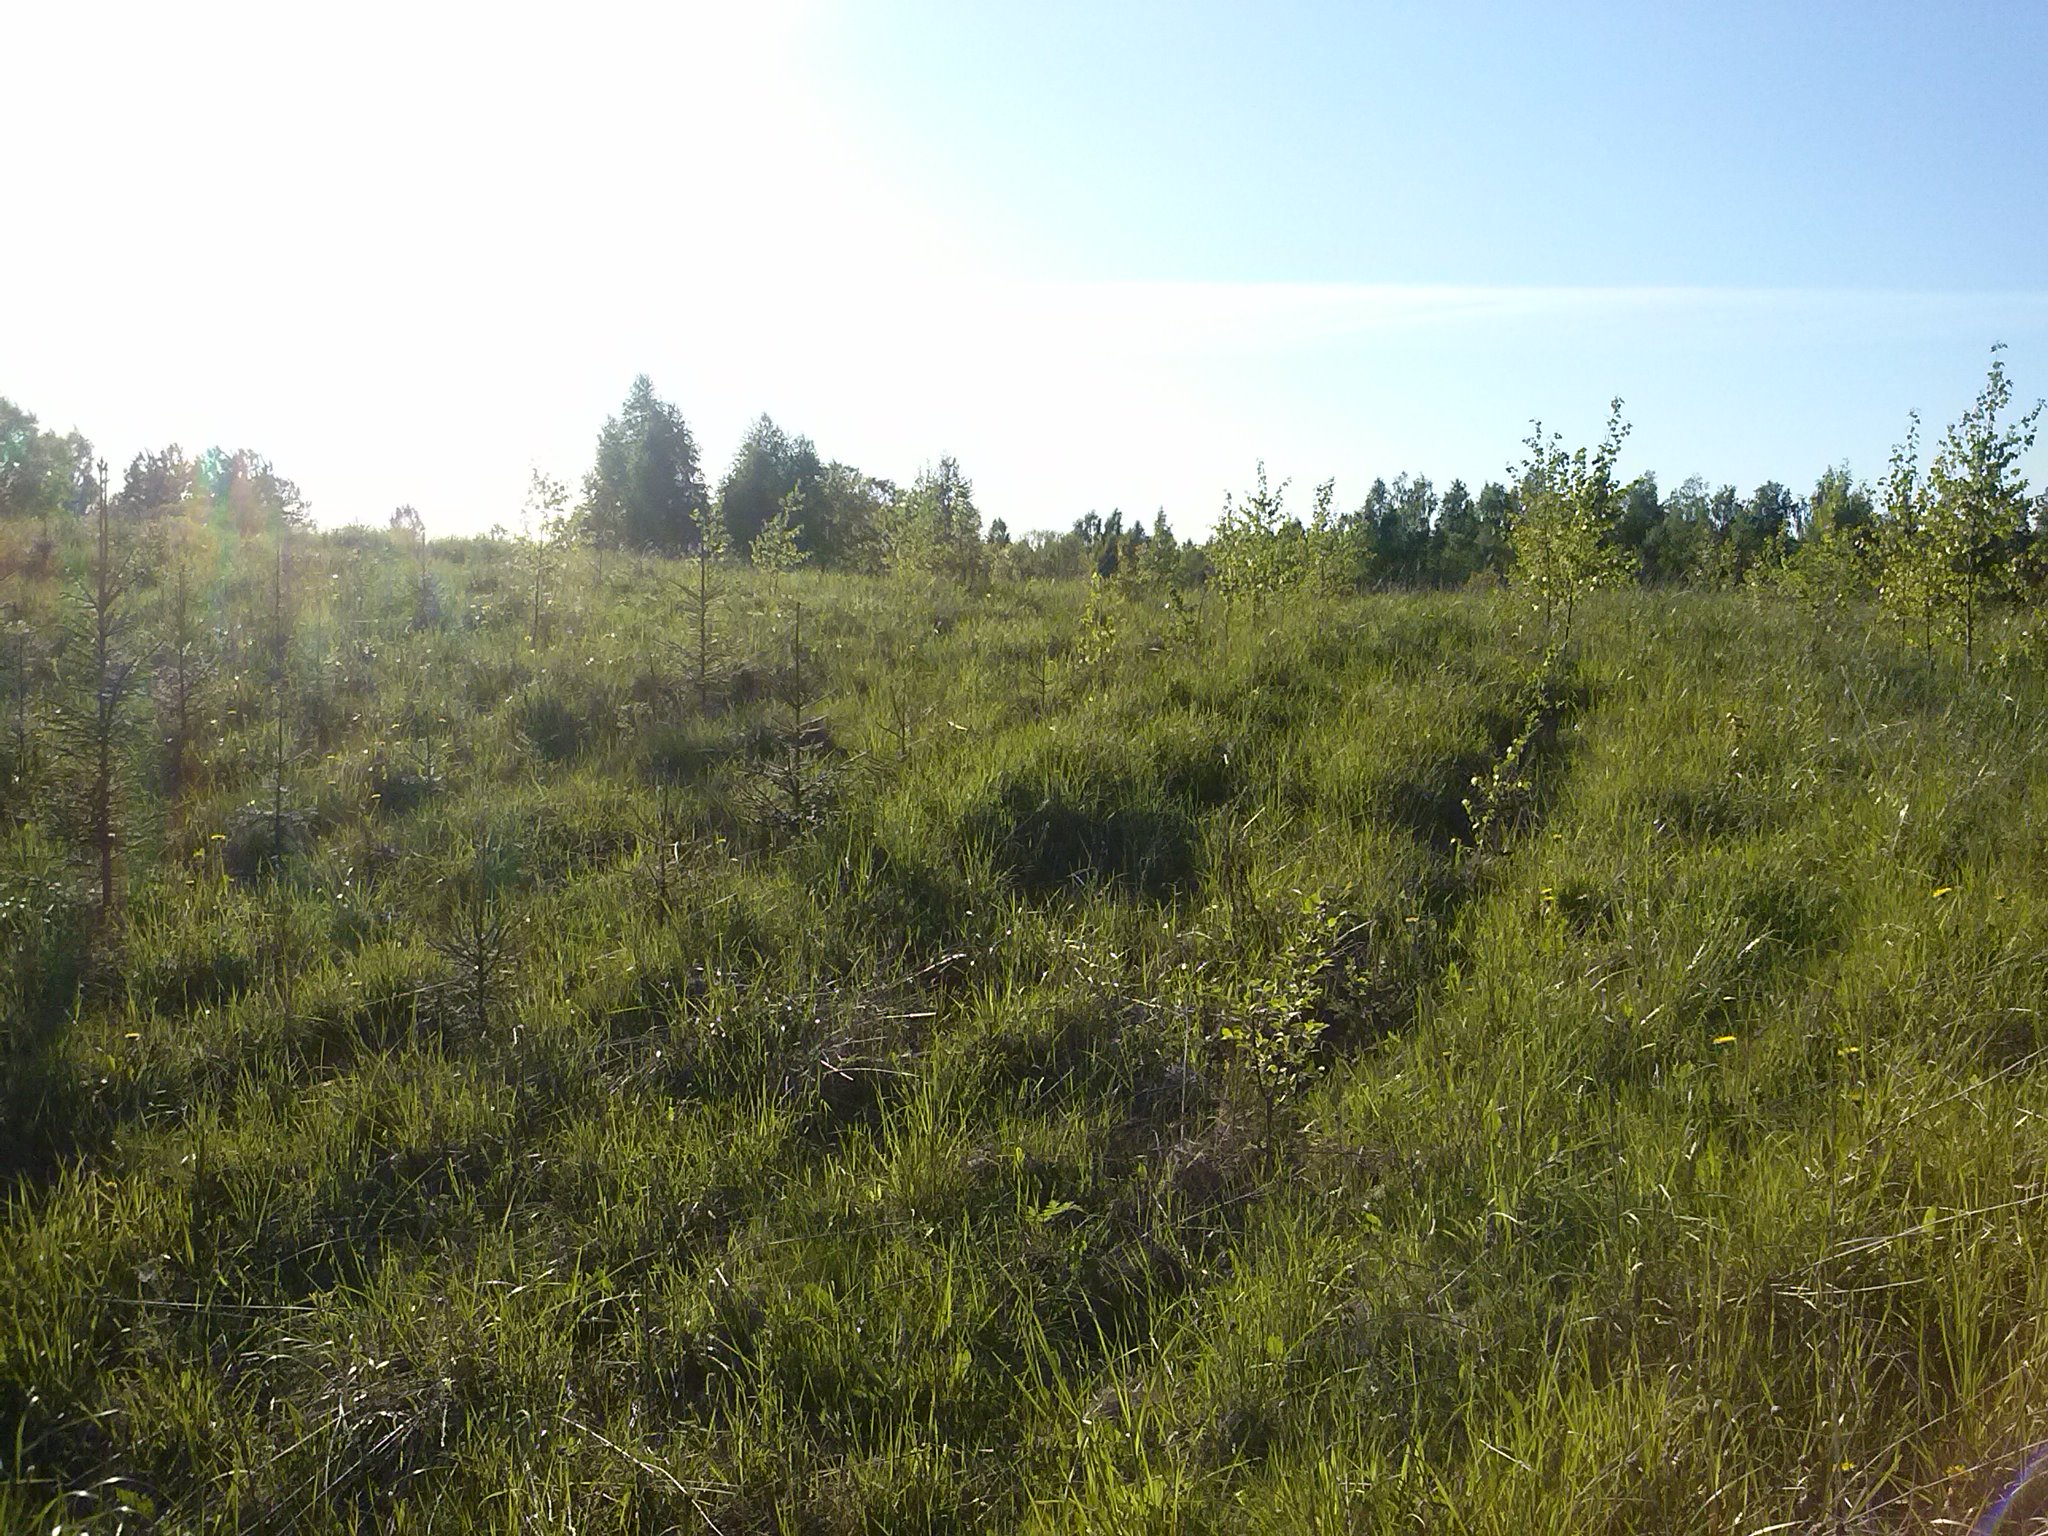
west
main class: Grassland
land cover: Grassland with sparse tree/shrub cover
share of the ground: > 75 %
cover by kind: herbaceous plants 90 %, coniferous forest trees 5 %, shrubs 5 %
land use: Forestry
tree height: < 5 m
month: May
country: LV
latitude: 56.1920
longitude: 27.8714
